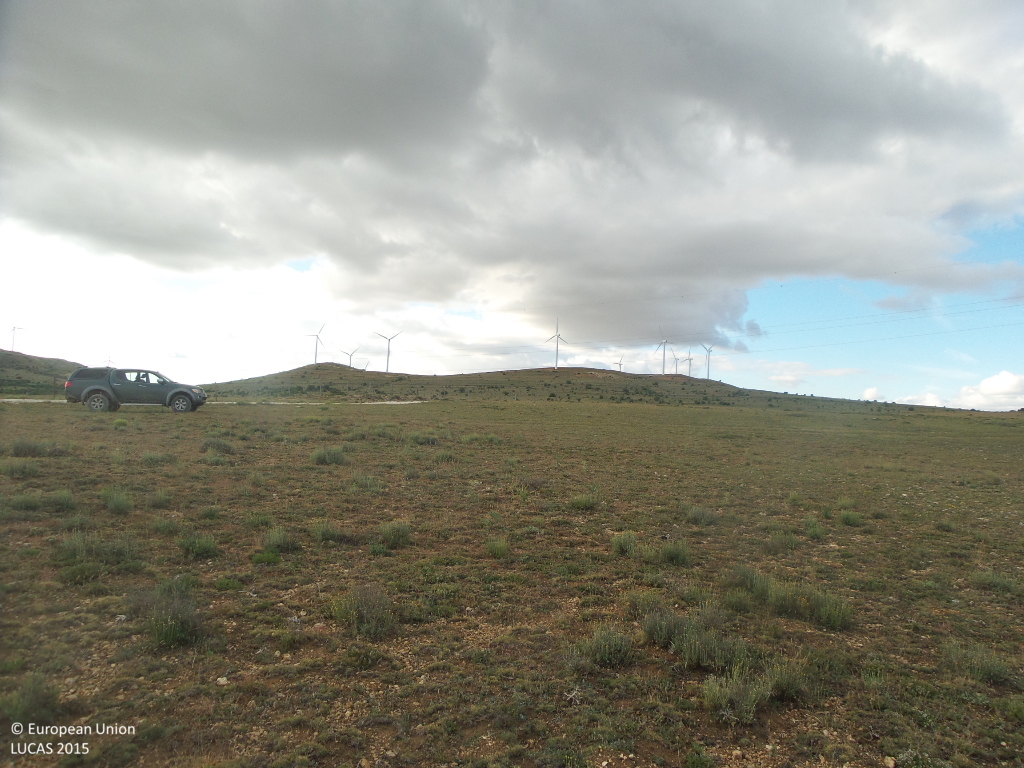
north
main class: Shrubland
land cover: Shrubland without tree cover
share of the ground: 50 - 75 %
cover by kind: shrubs 60 %, unconsolidated bare surface 30 %, herbaceous plants 10 %
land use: Abandoned areas
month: June
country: ES
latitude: 41.2823
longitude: -3.1385
